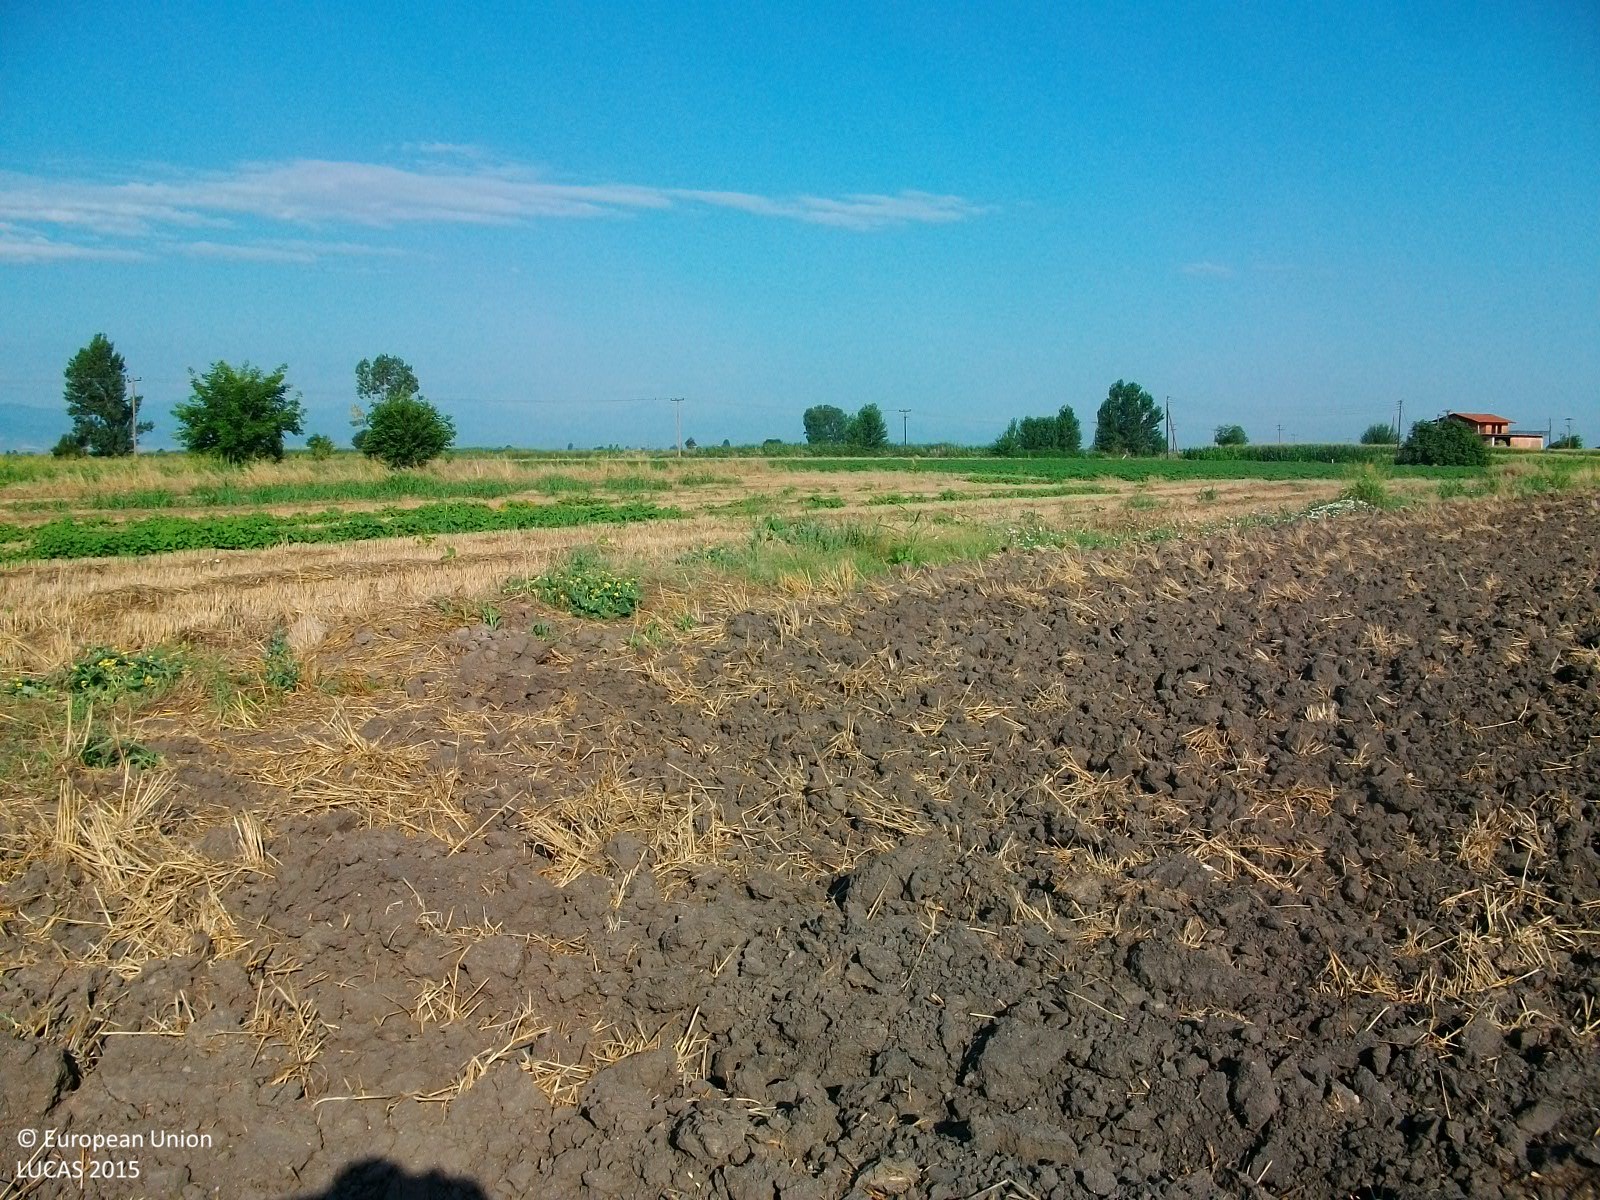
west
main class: Grassland
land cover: Spontaneously vegetated surfaces
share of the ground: > 75 %
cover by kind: herbaceous plants 100 %
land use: Fallow land
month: July
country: GR
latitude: 39.2551
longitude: 22.2792
